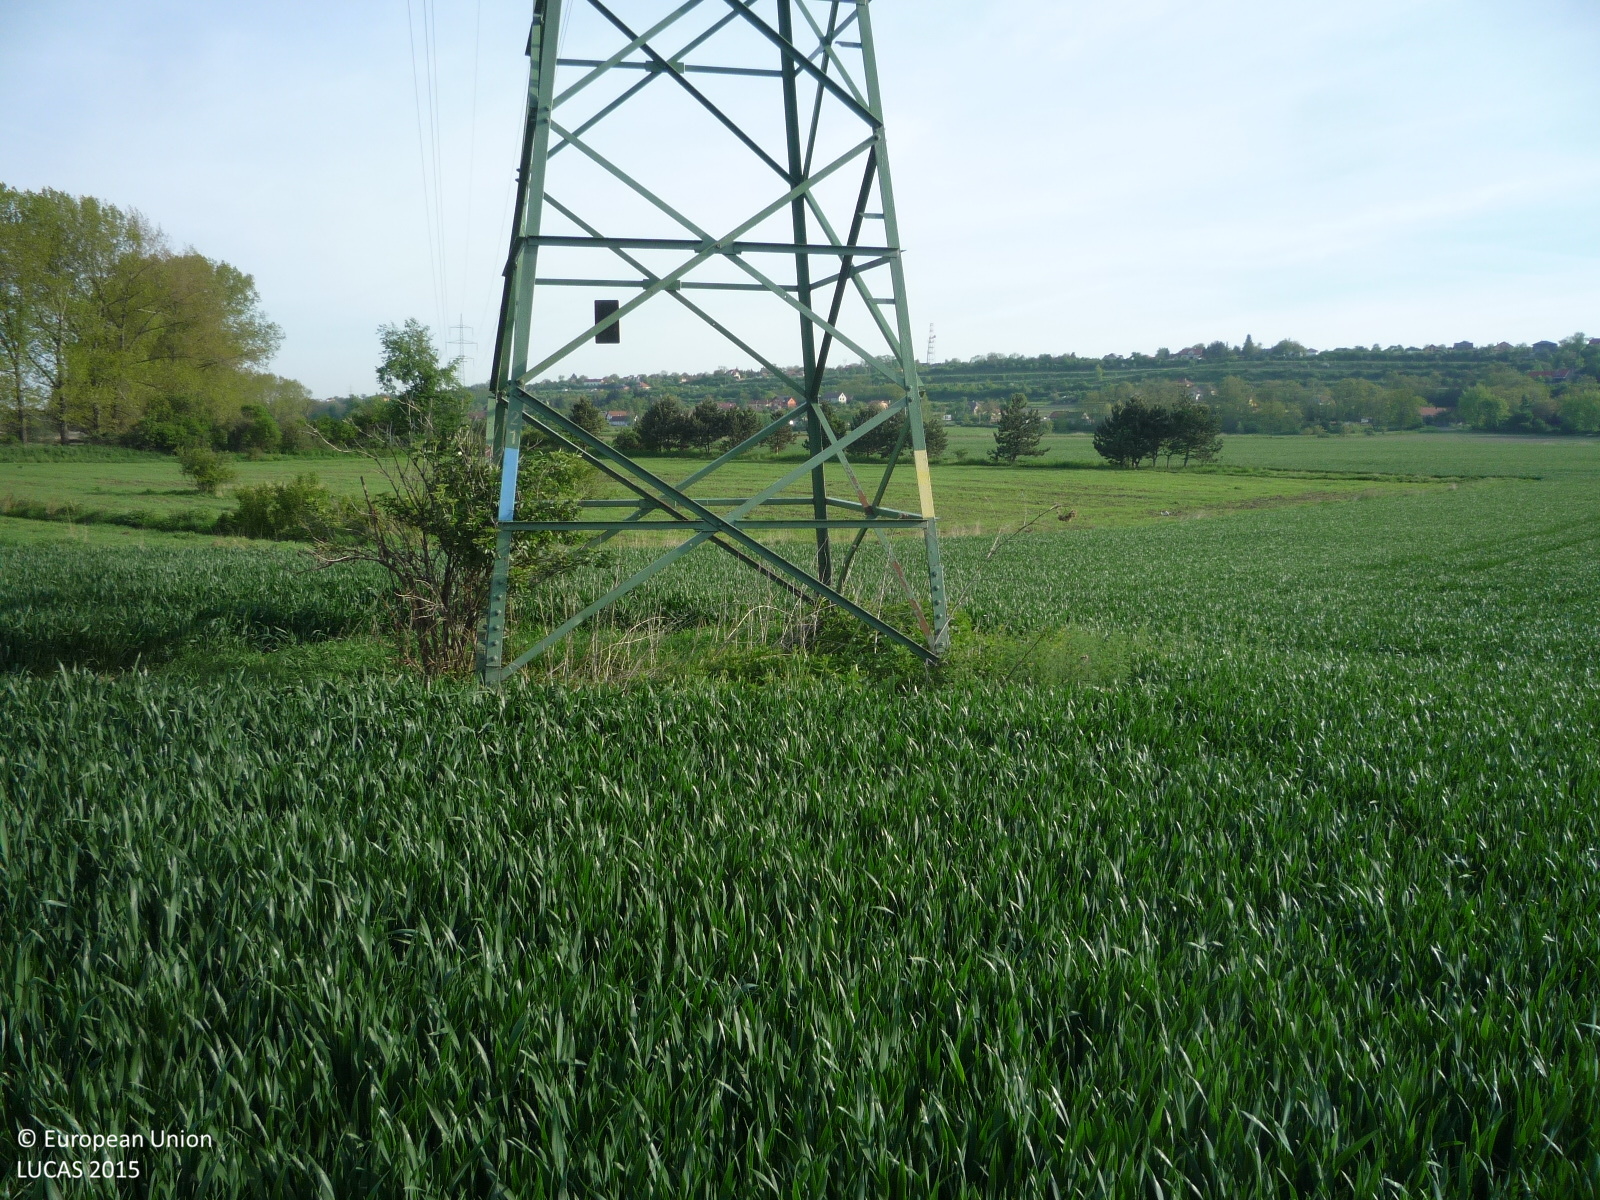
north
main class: Cropland
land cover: Common wheat
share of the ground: > 75 %
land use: Agriculture (excluding fallow land and kitchen gardens)
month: May
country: CZ
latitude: 50.3112
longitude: 14.5093
